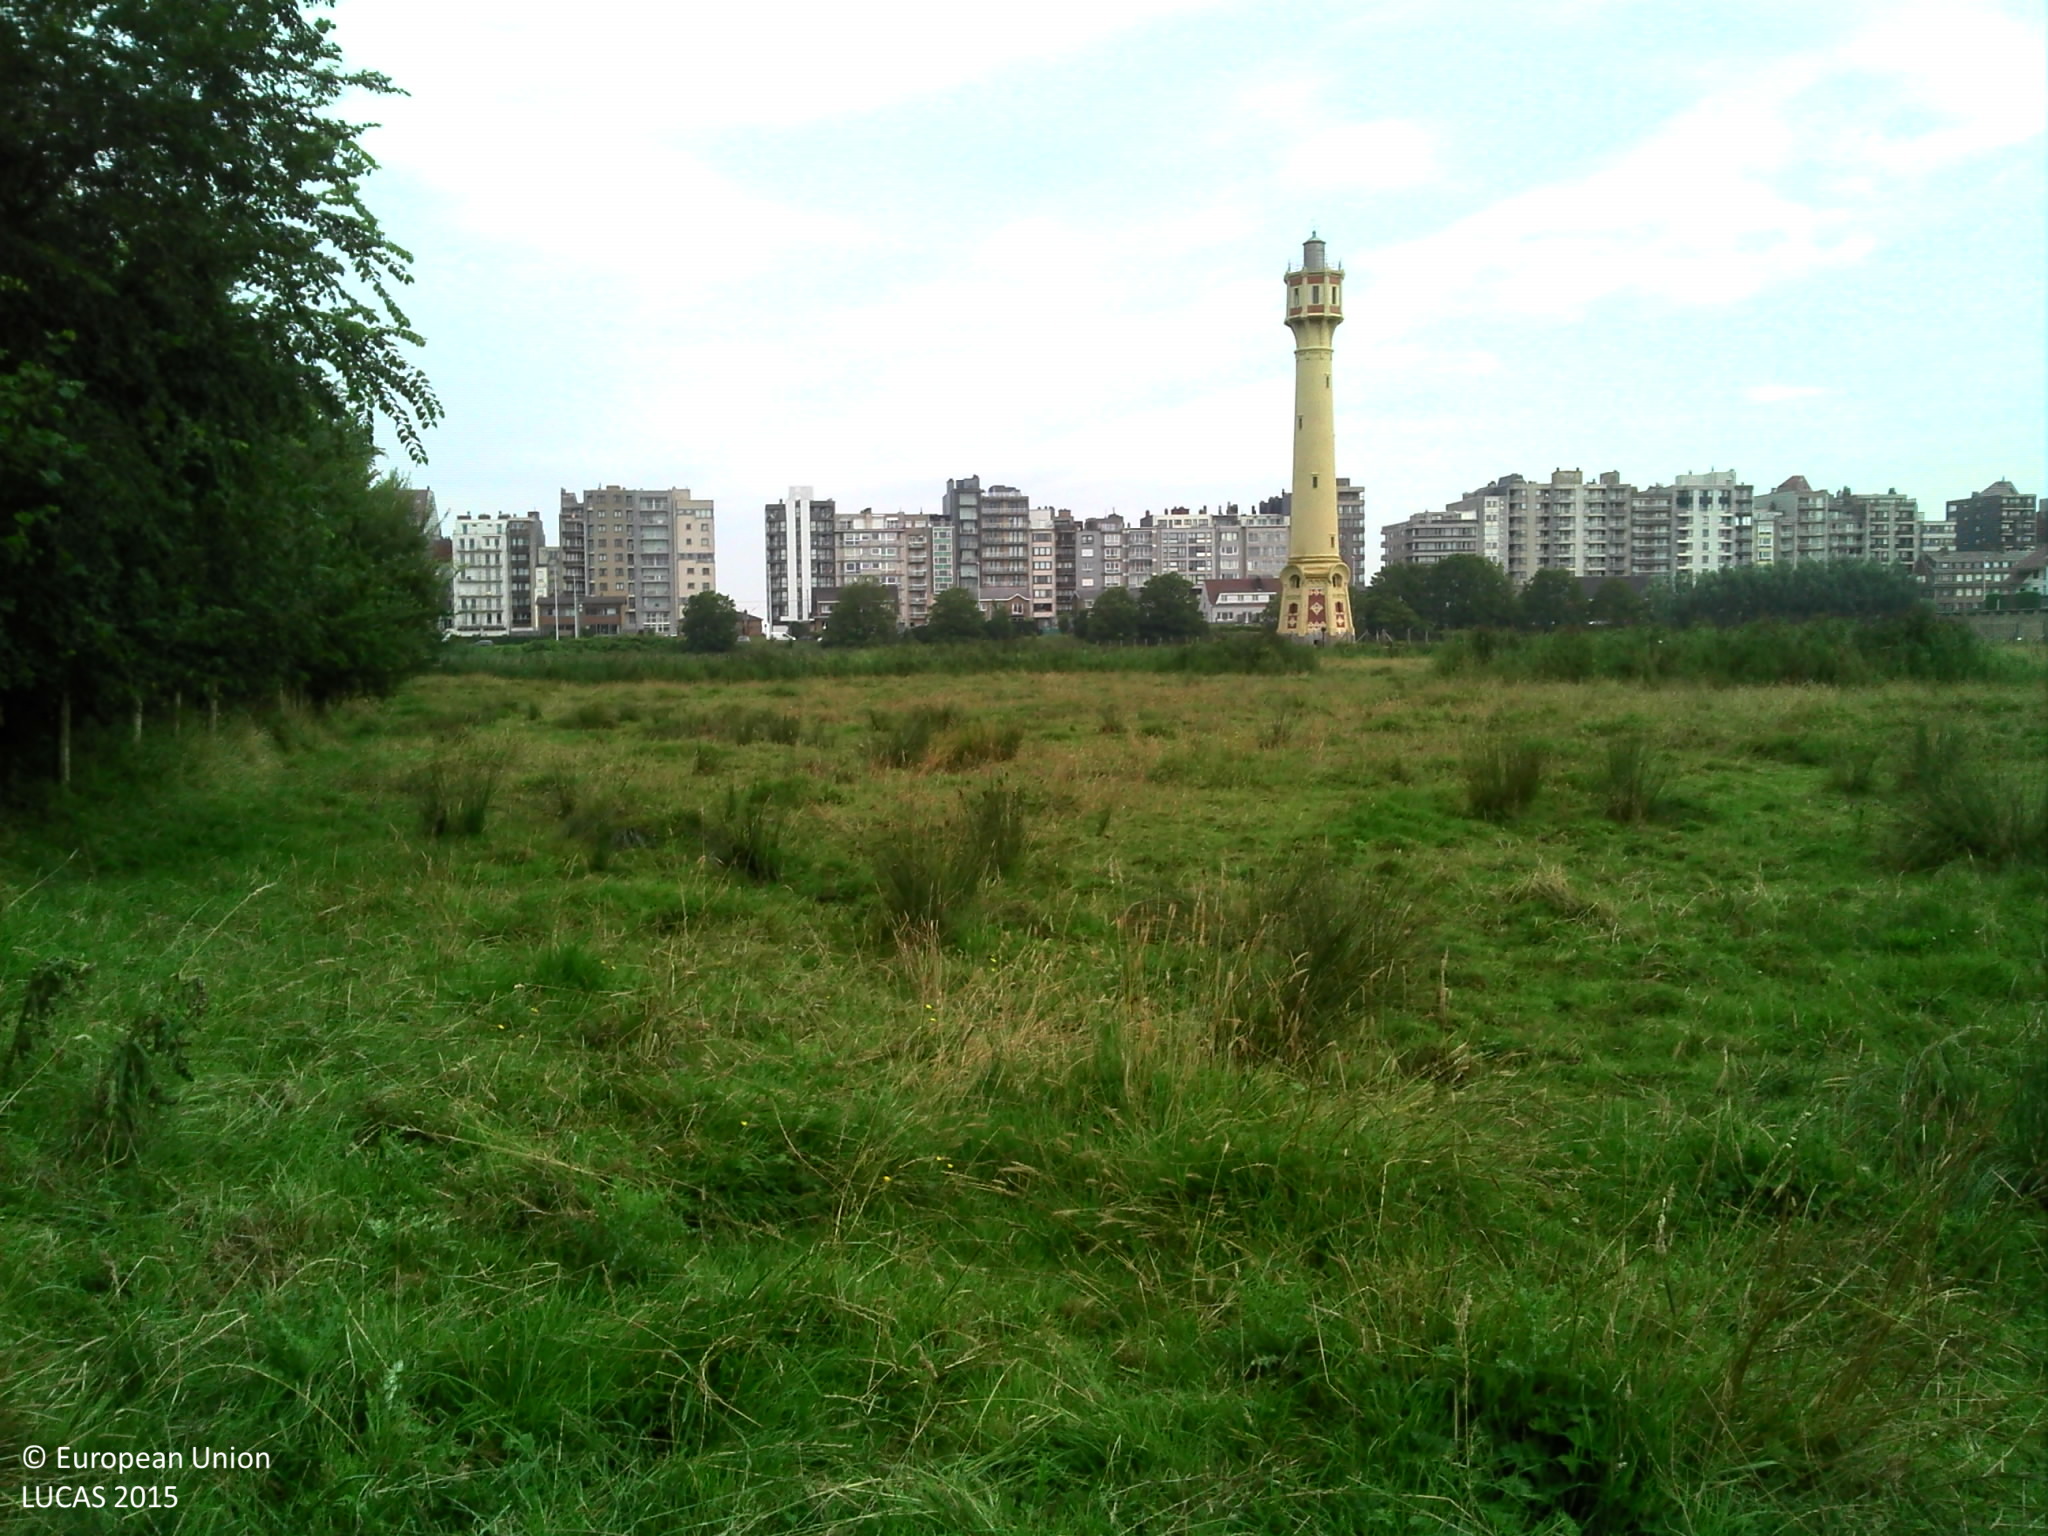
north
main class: Grassland
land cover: Grassland without tree/shrub cover
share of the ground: > 75 %
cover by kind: herbaceous plants 100 %
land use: Agriculture (excluding fallow land and kitchen gardens)
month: August
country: BE
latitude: 51.3363
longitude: 3.2302
